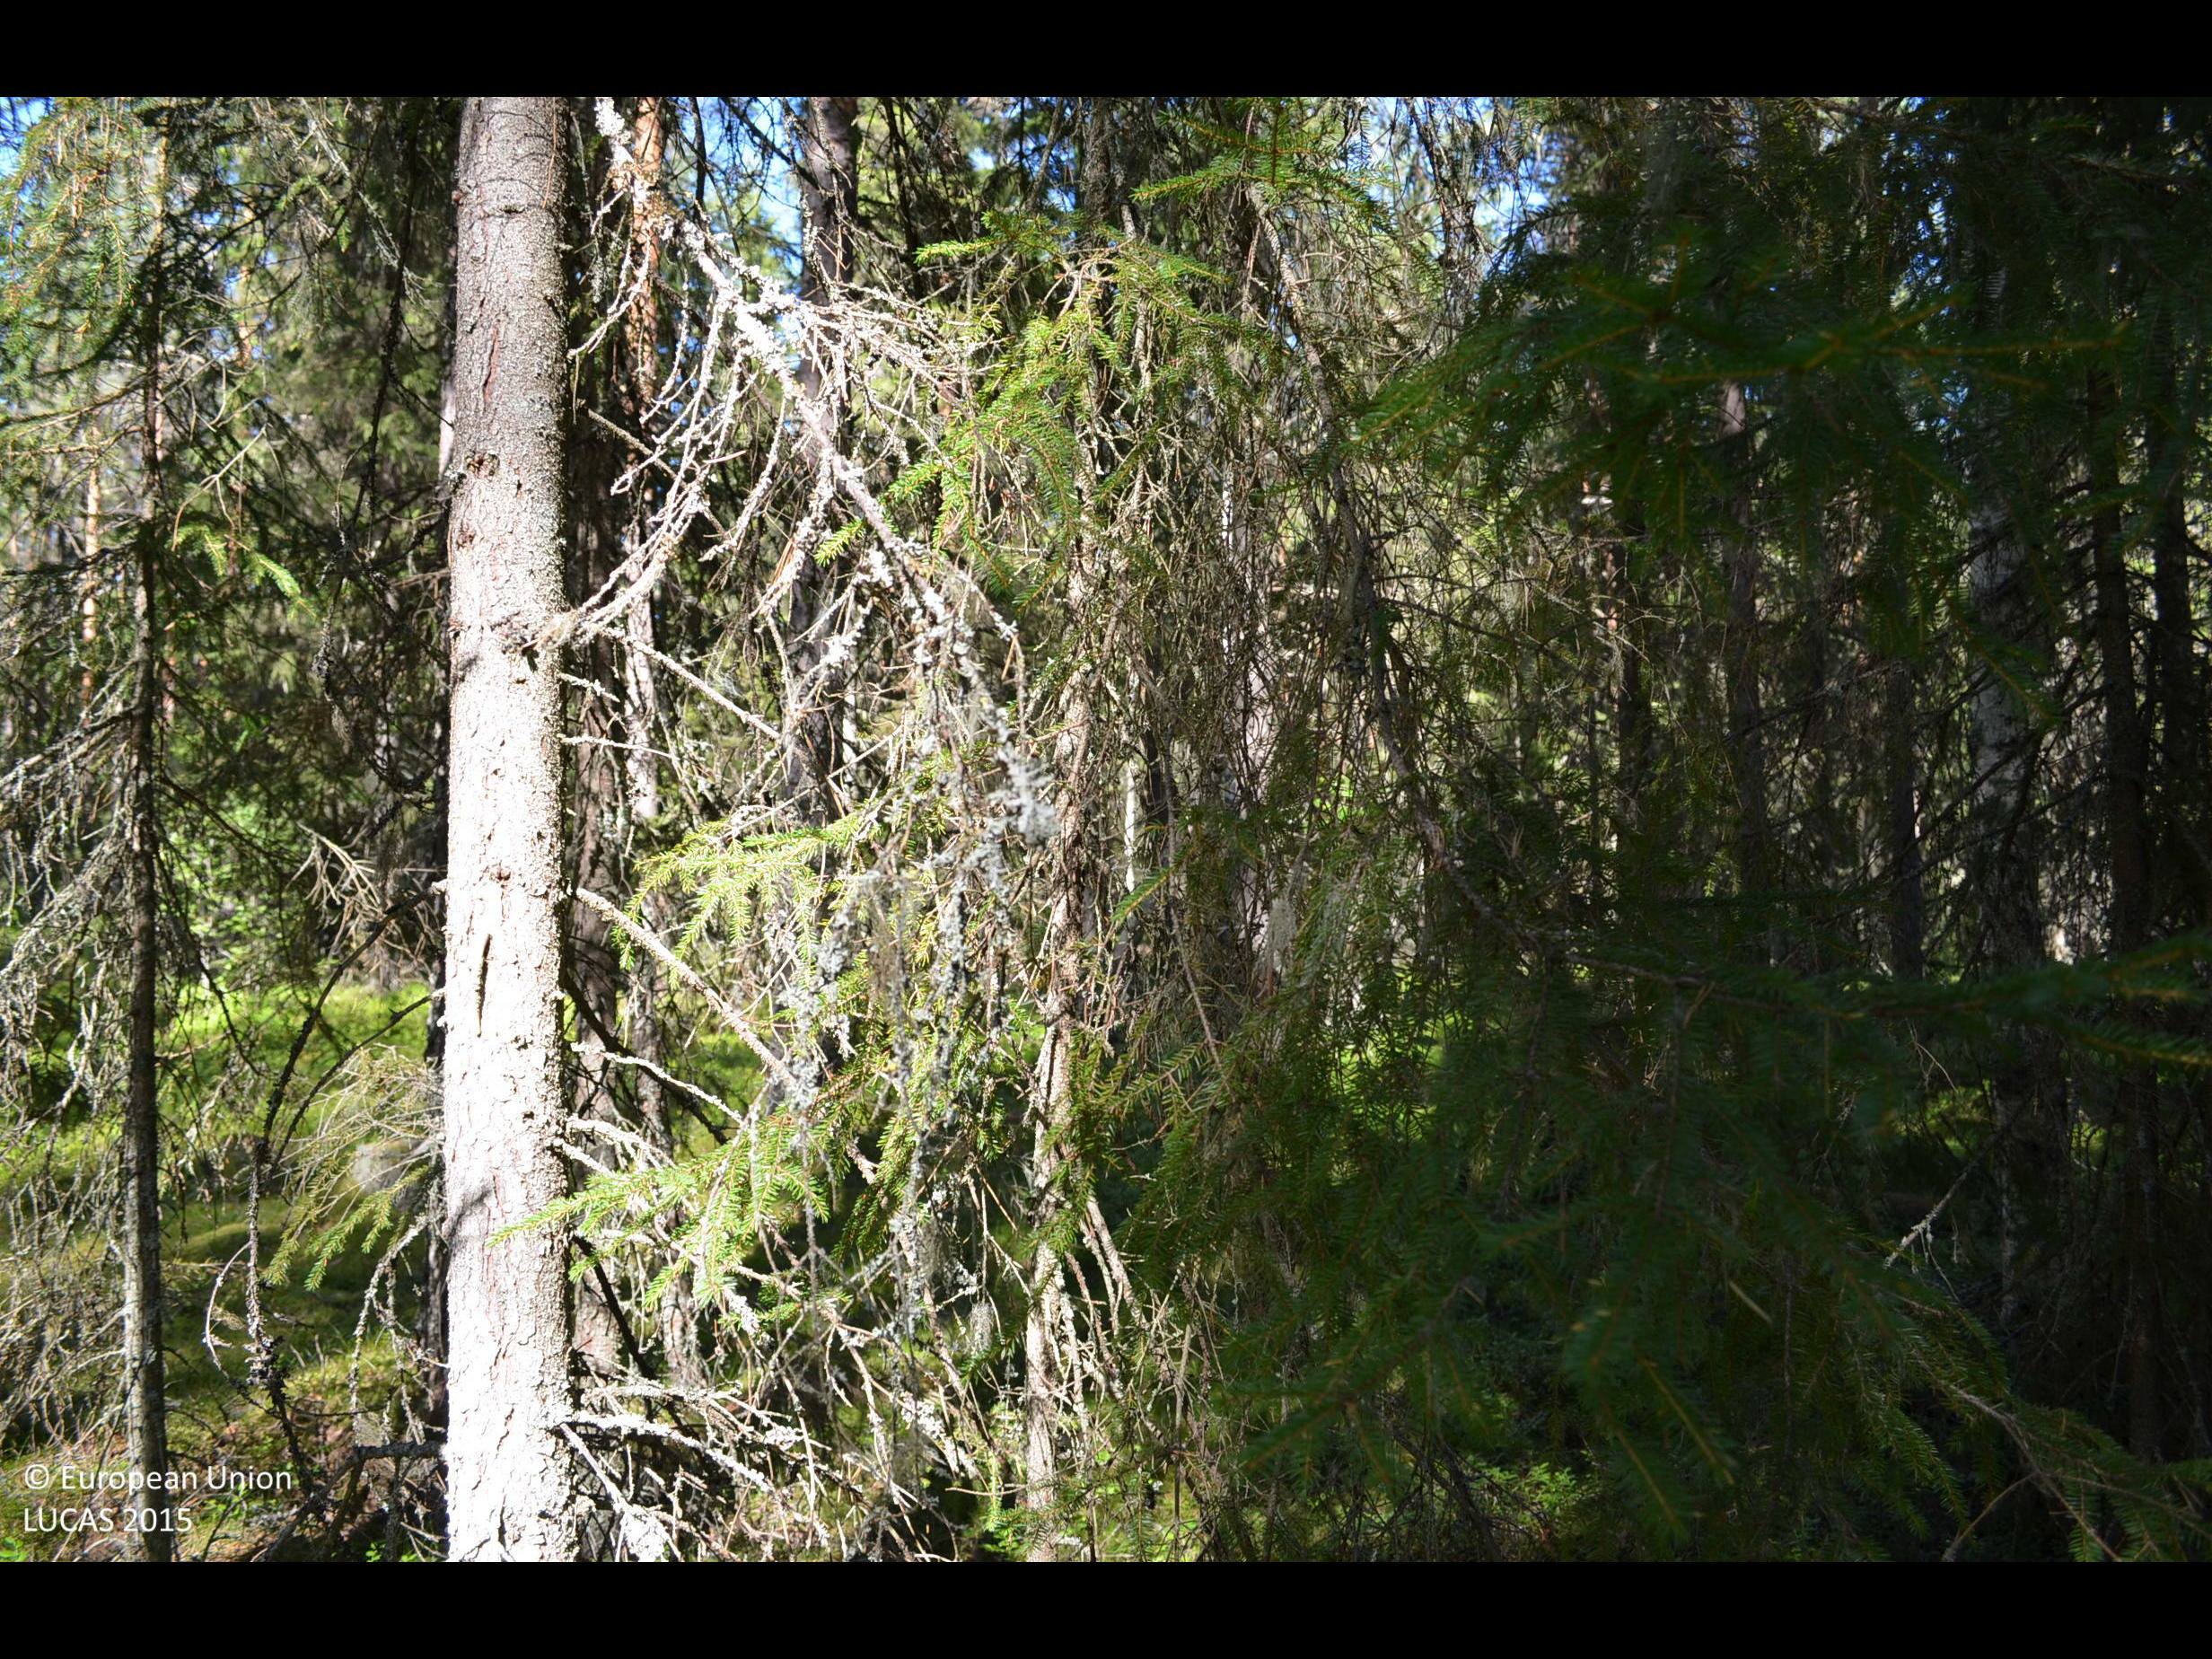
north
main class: Woodland
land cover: Other coniferous woodland
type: boreal forest
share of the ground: > 75 %
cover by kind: coniferous forest trees 70 %, shrubs 15 %, lichens and mosses 10 %, broadleaved forest trees 5 %
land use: Forestry
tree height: > 5 m
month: August
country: FI
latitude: 62.3808
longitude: 24.3378
